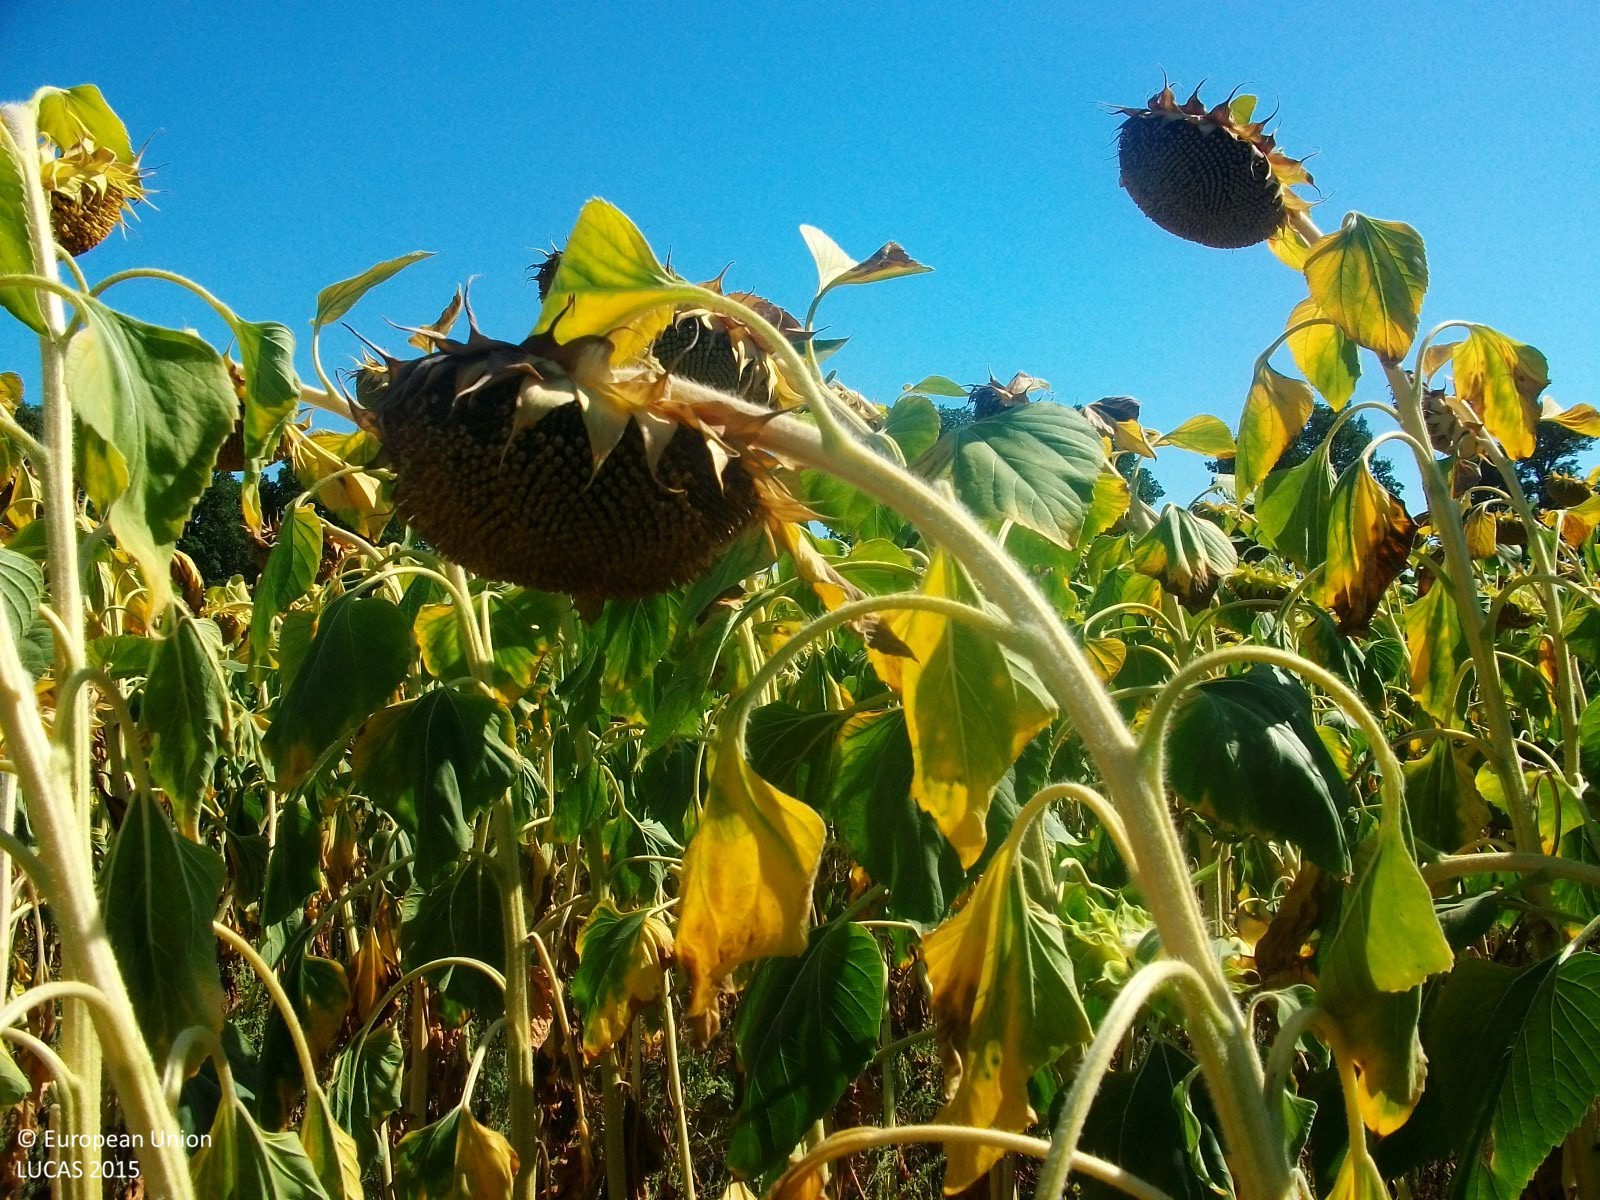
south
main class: Cropland
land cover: Sunflower
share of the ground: > 75 %
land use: Agriculture (excluding fallow land and kitchen gardens)
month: July
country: GR
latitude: 41.4139
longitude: 26.3079
